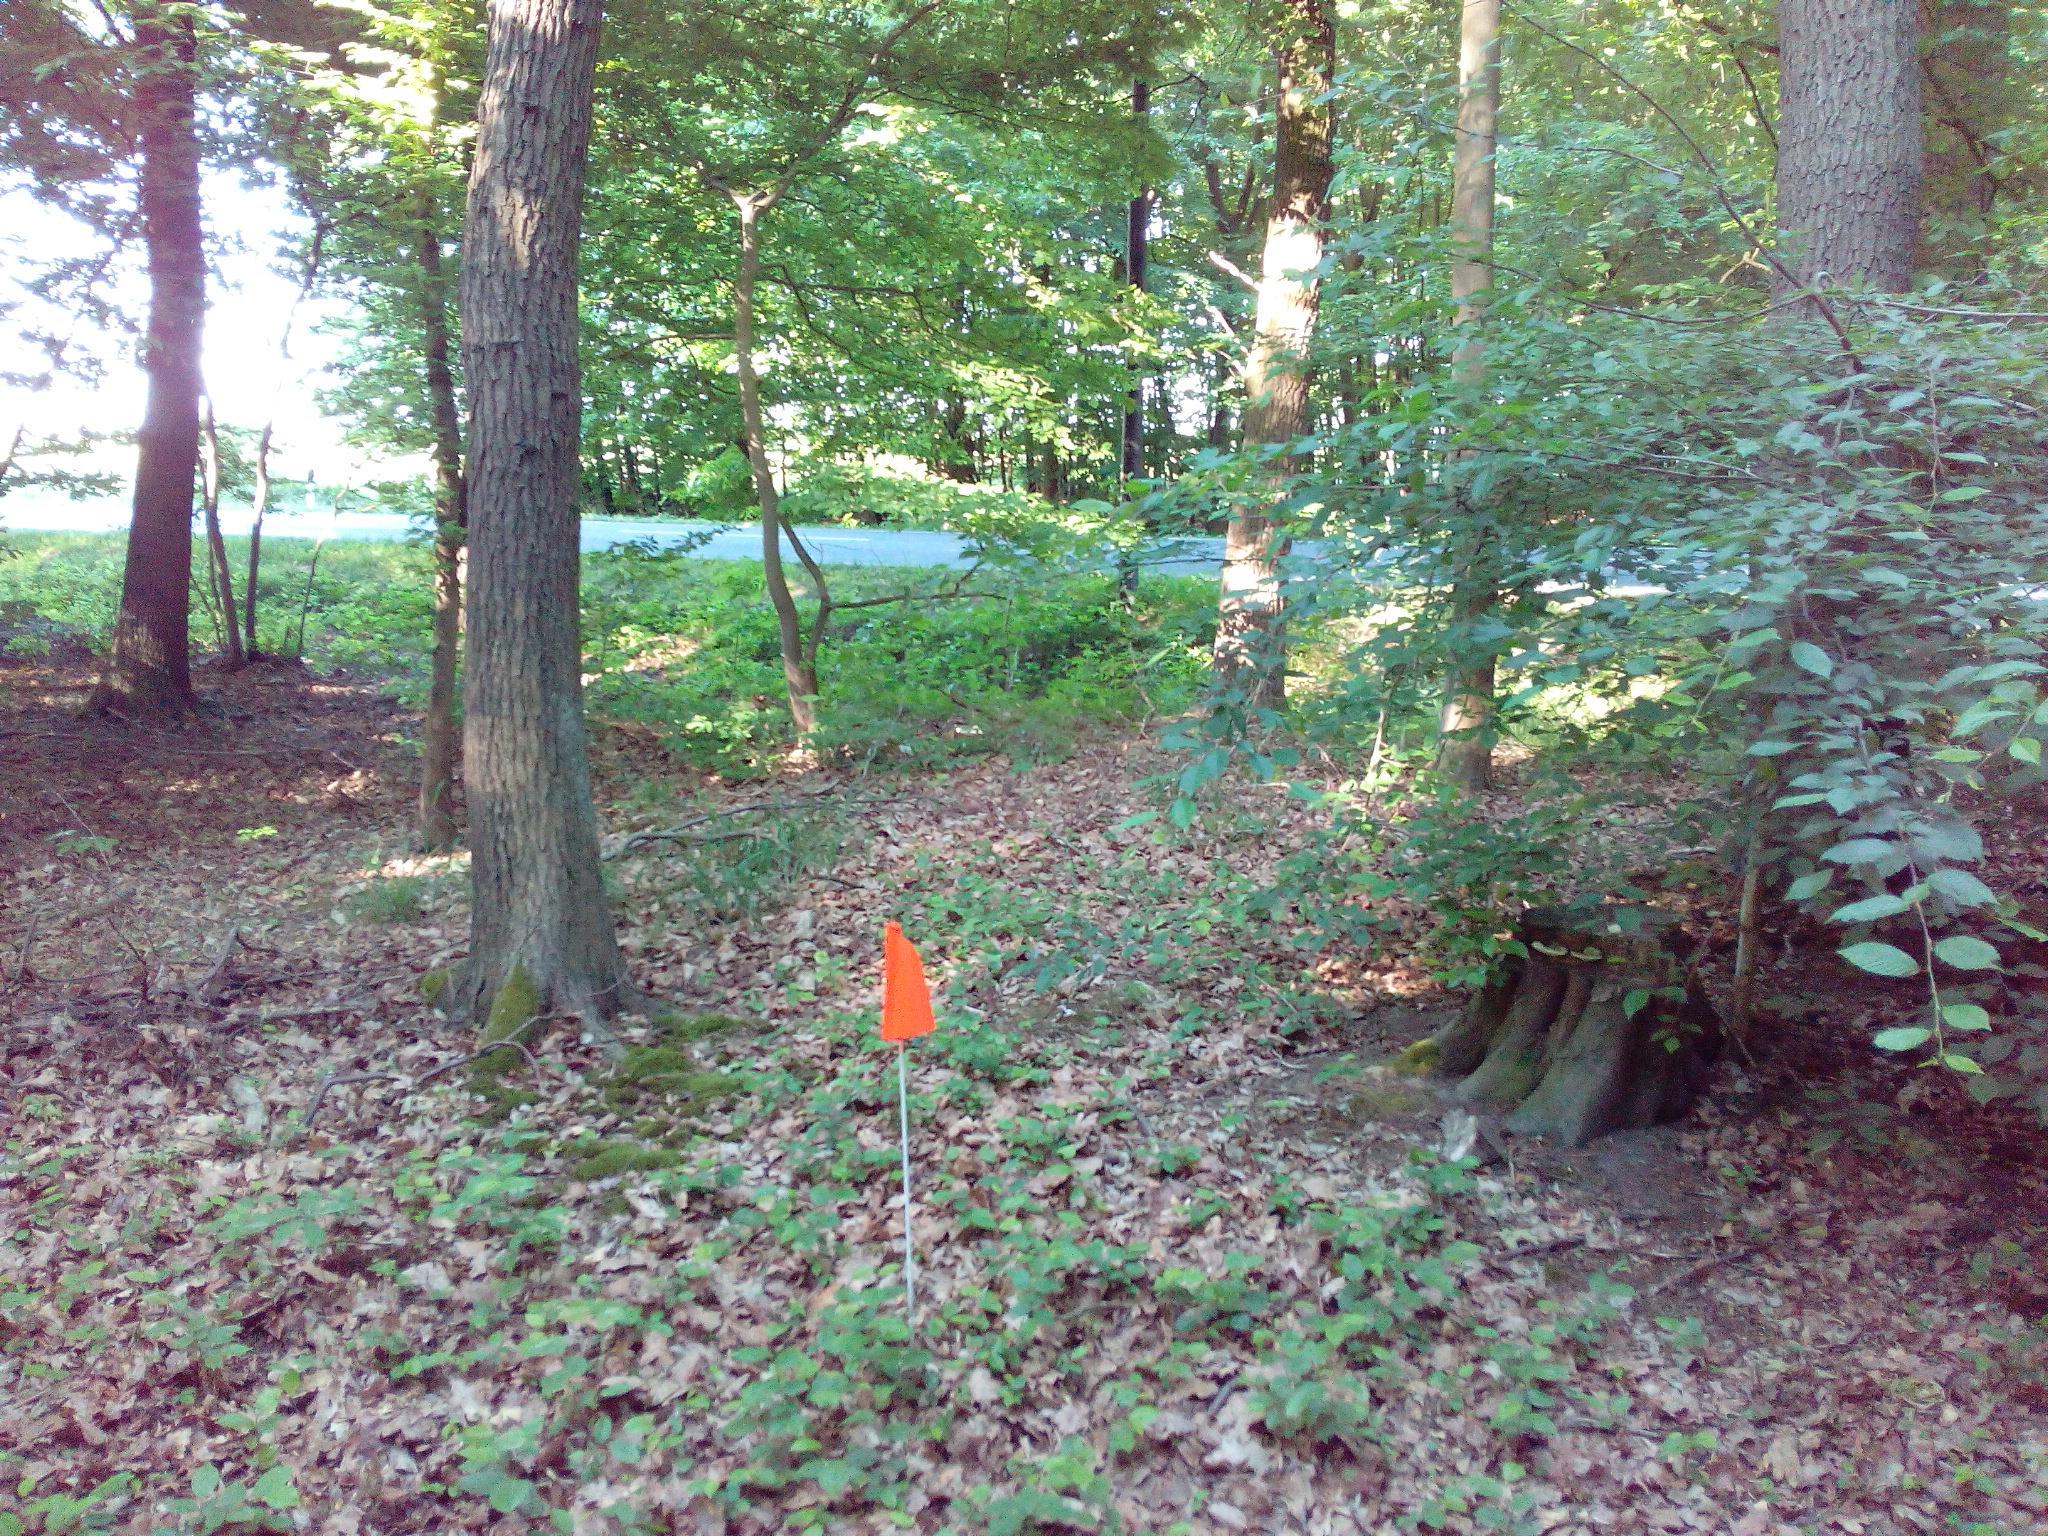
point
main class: Woodland
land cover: Broadleaved woodland
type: hemiboreal forest and nemoral coniferous forest and mixed broadleaved-coniferous forest
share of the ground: > 75 %
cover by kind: broadleaved forest trees 90 %, shrubs 5 %, herbaceous plants 5 %
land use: Forestry
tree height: > 5 m
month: June
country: DE
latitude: 52.3055
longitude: 9.8974
